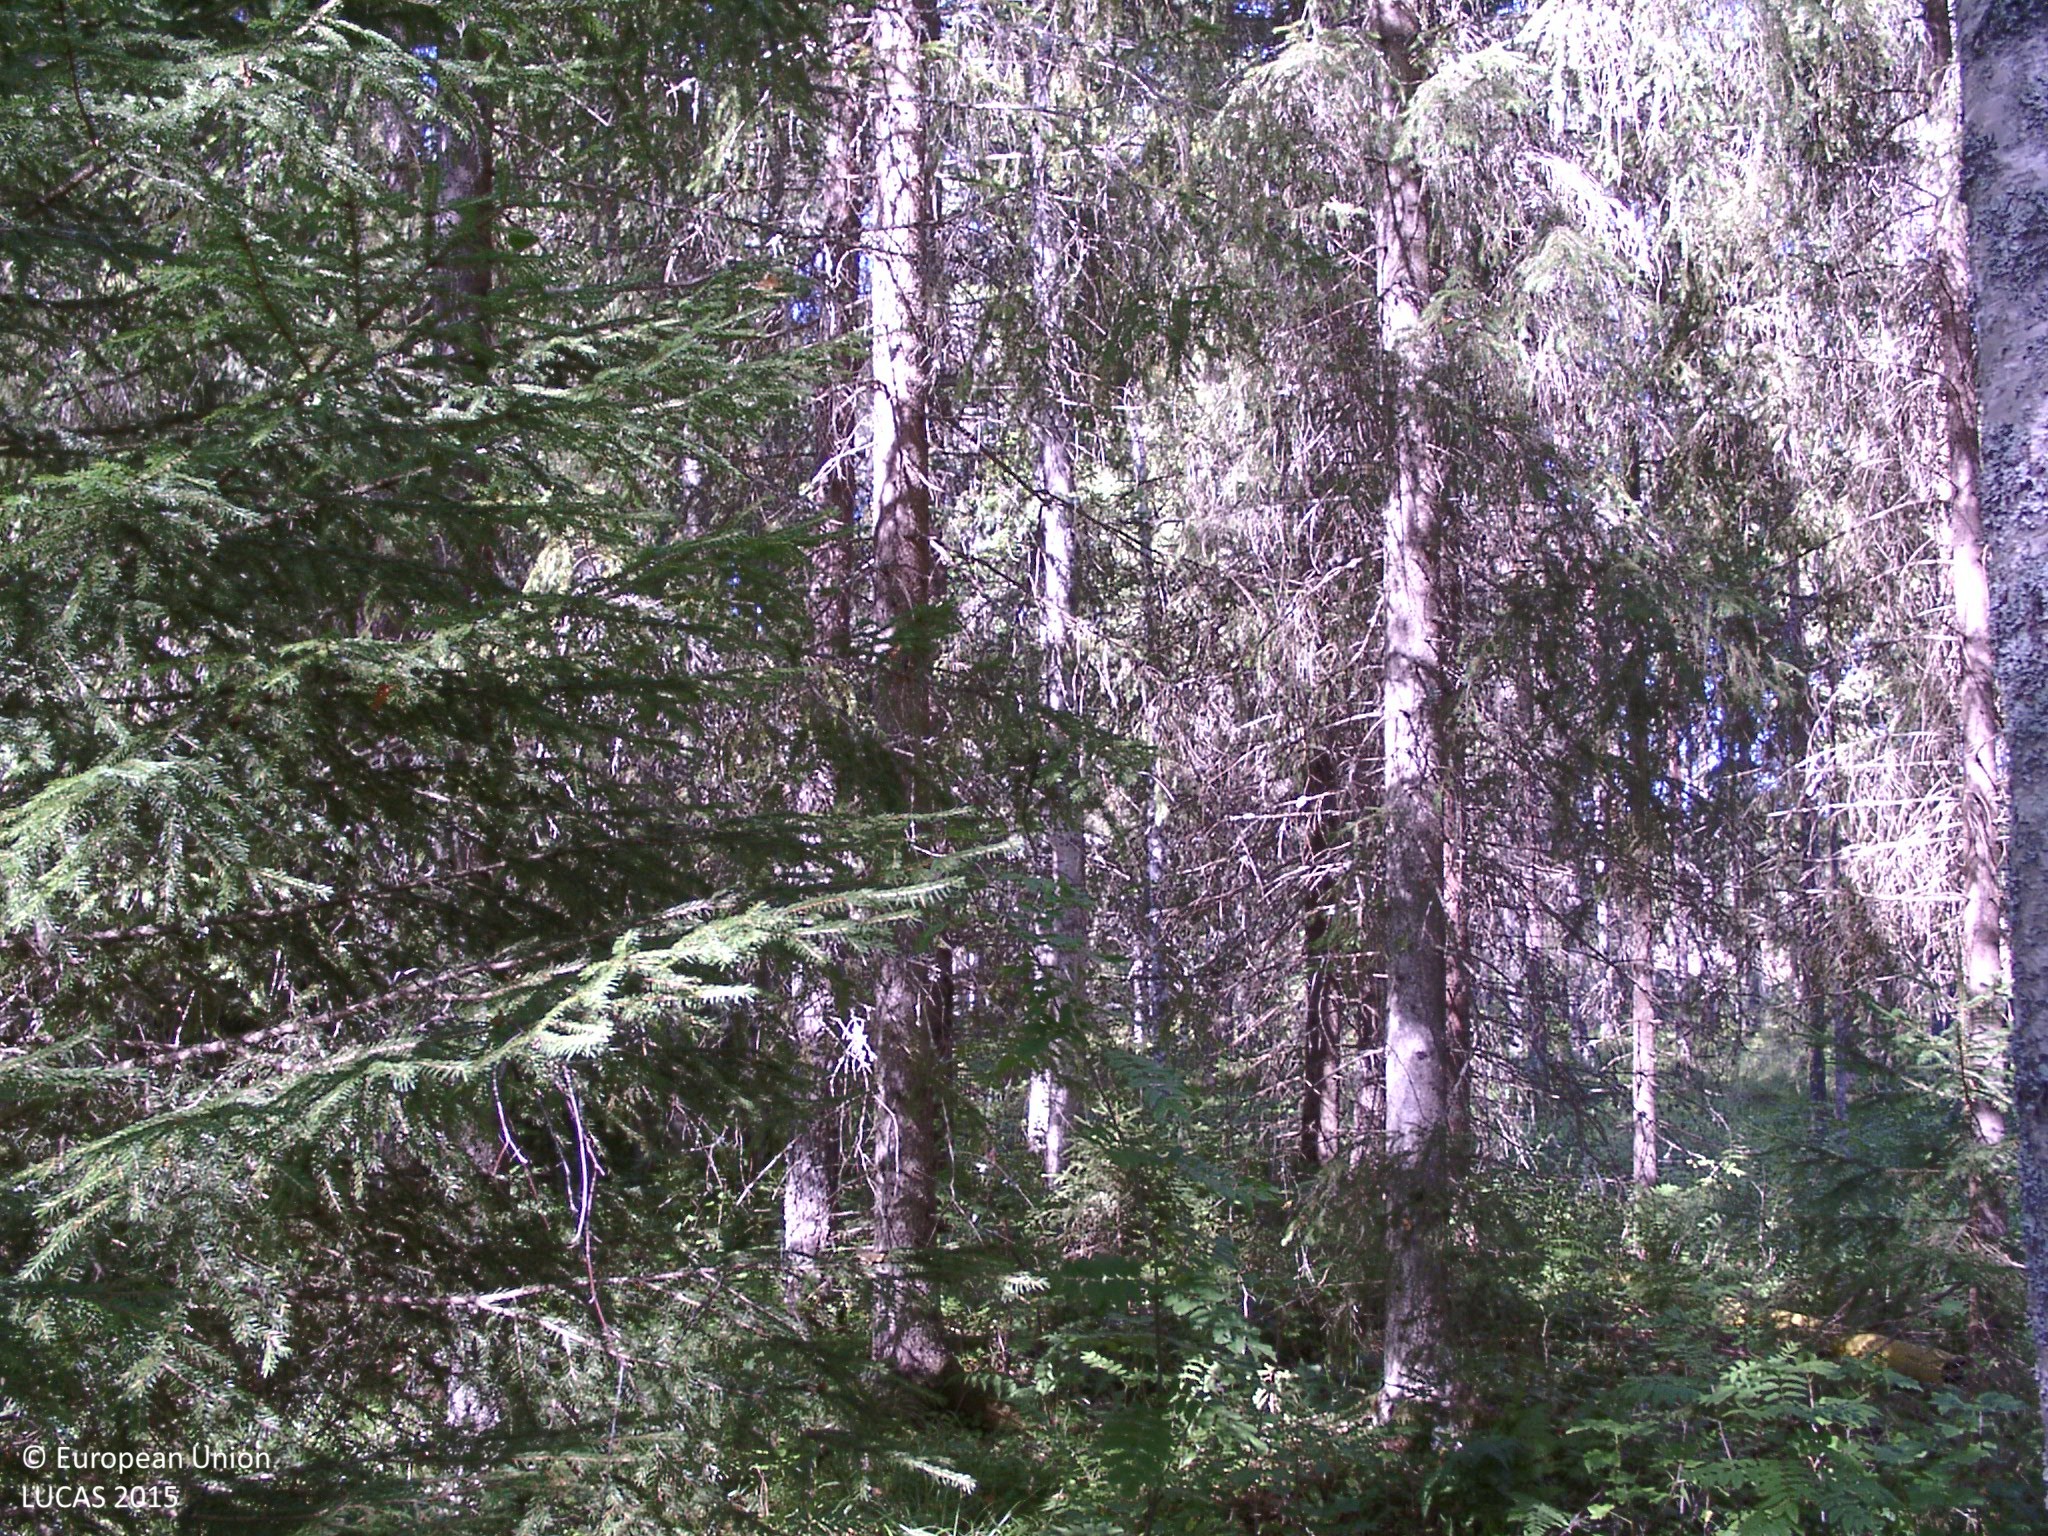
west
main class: Woodland
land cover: Spruce dominated mixed woodland
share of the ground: 50 - 75 %
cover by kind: broadleaved forest trees 50 %, herbaceous plants 25 %, coniferous forest trees 20 %, lichens and mosses 5 %
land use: Forestry
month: August
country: FI
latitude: 62.4034
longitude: 25.2185
